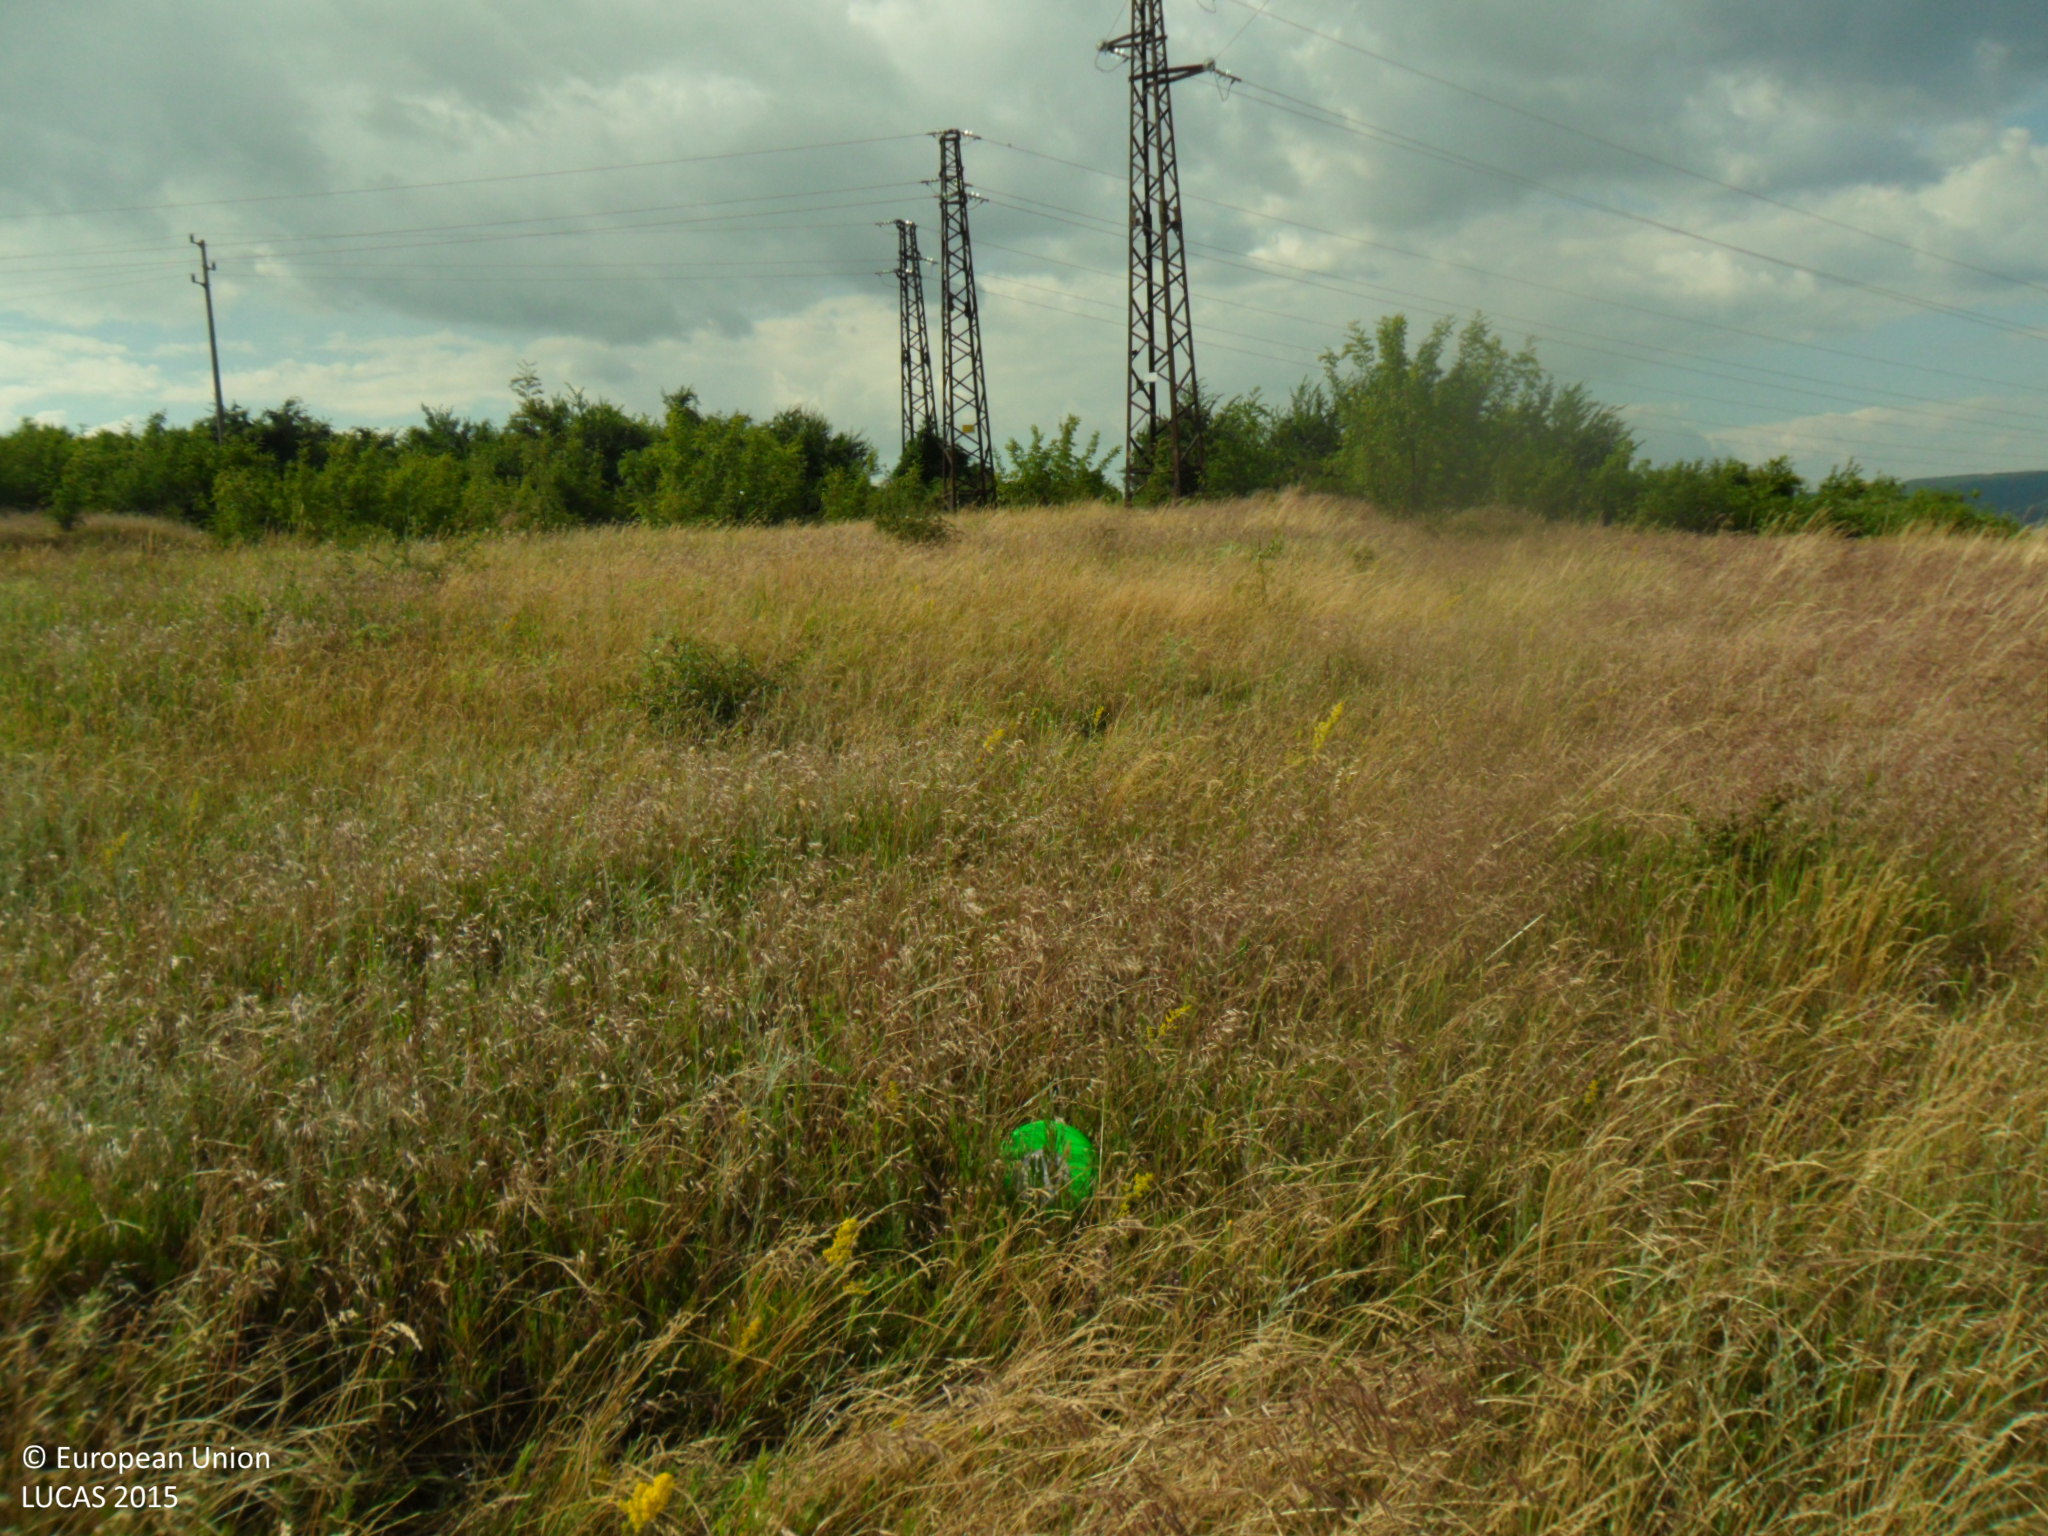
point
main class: Grassland
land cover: Grassland without tree/shrub cover
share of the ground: > 75 %
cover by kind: herbaceous plants 95 %, shrubs 5 %
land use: Agriculture (excluding fallow land and kitchen gardens)
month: June
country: BG
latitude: 43.1671
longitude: 26.8246
